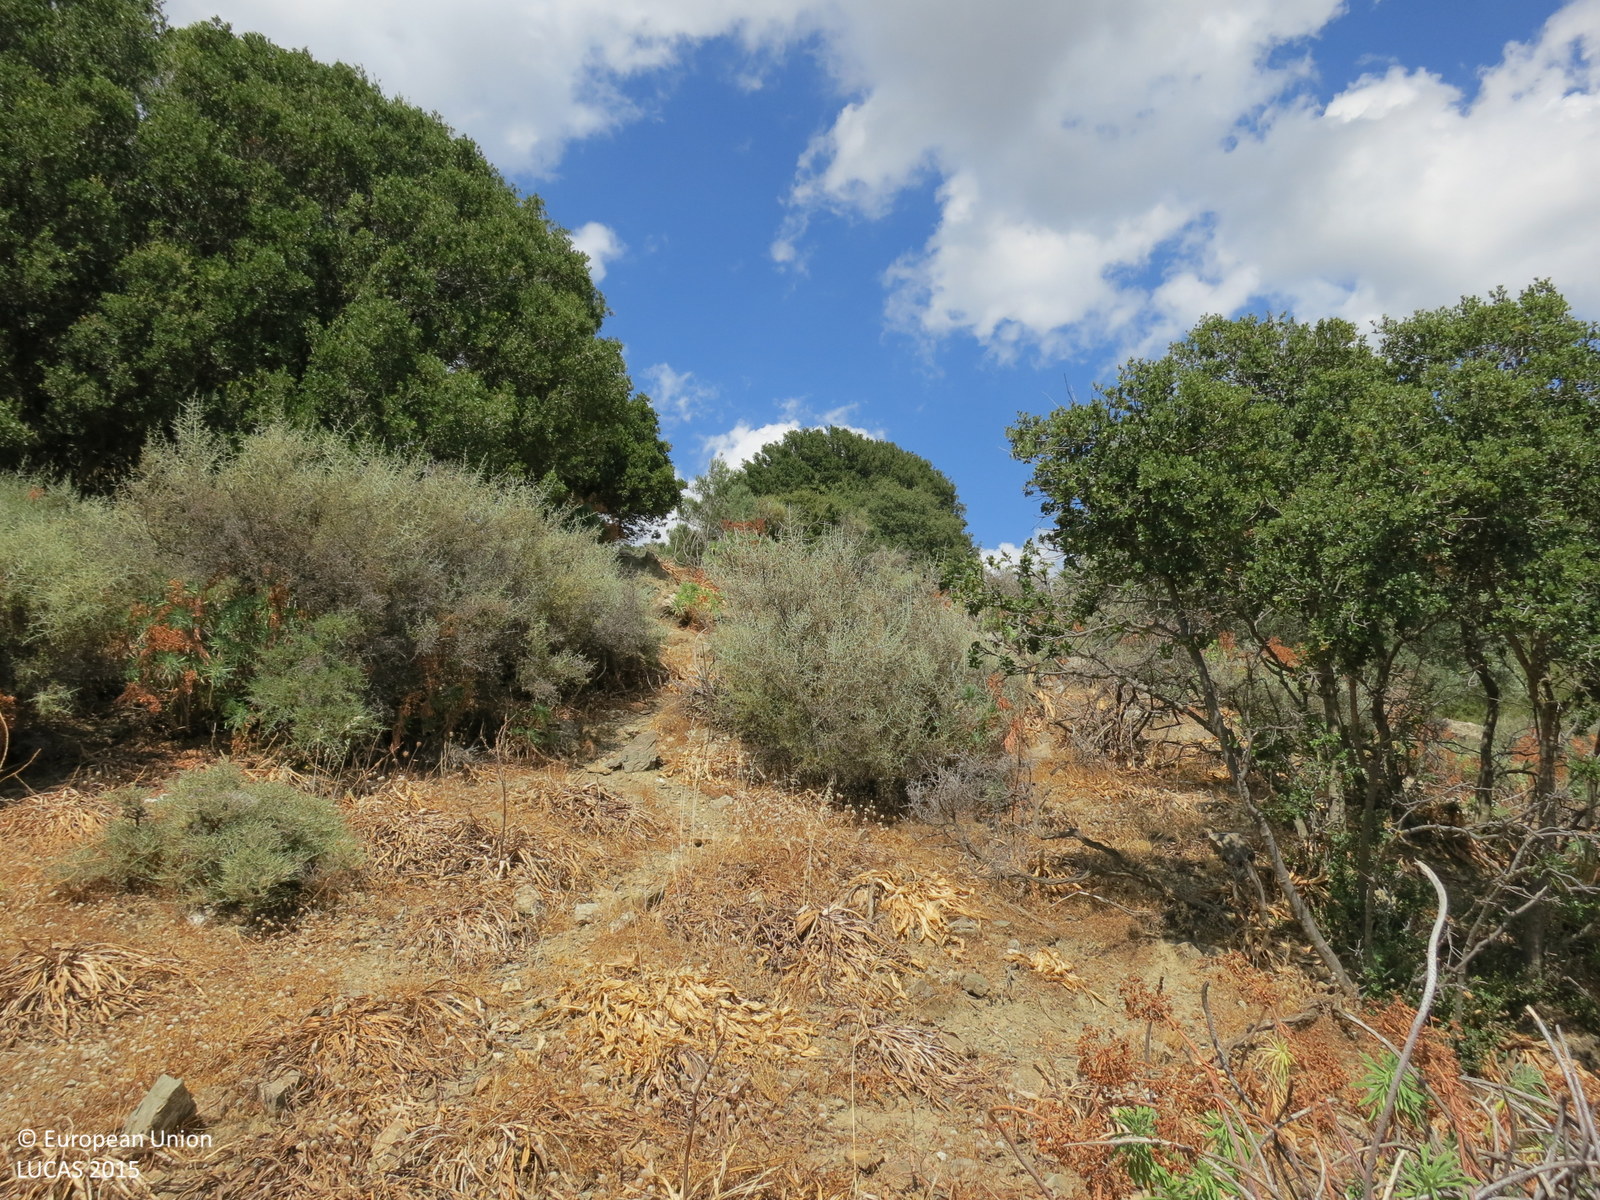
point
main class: Shrubland
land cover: Shrubland with sparse tree cover
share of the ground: > 75 %
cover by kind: shrubs 80 %, herbaceous plants 15 %, broadleaved forest trees 5 %
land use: Abandoned areas
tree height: < 5 m
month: June
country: GR
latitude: 35.1435
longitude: 24.8146
